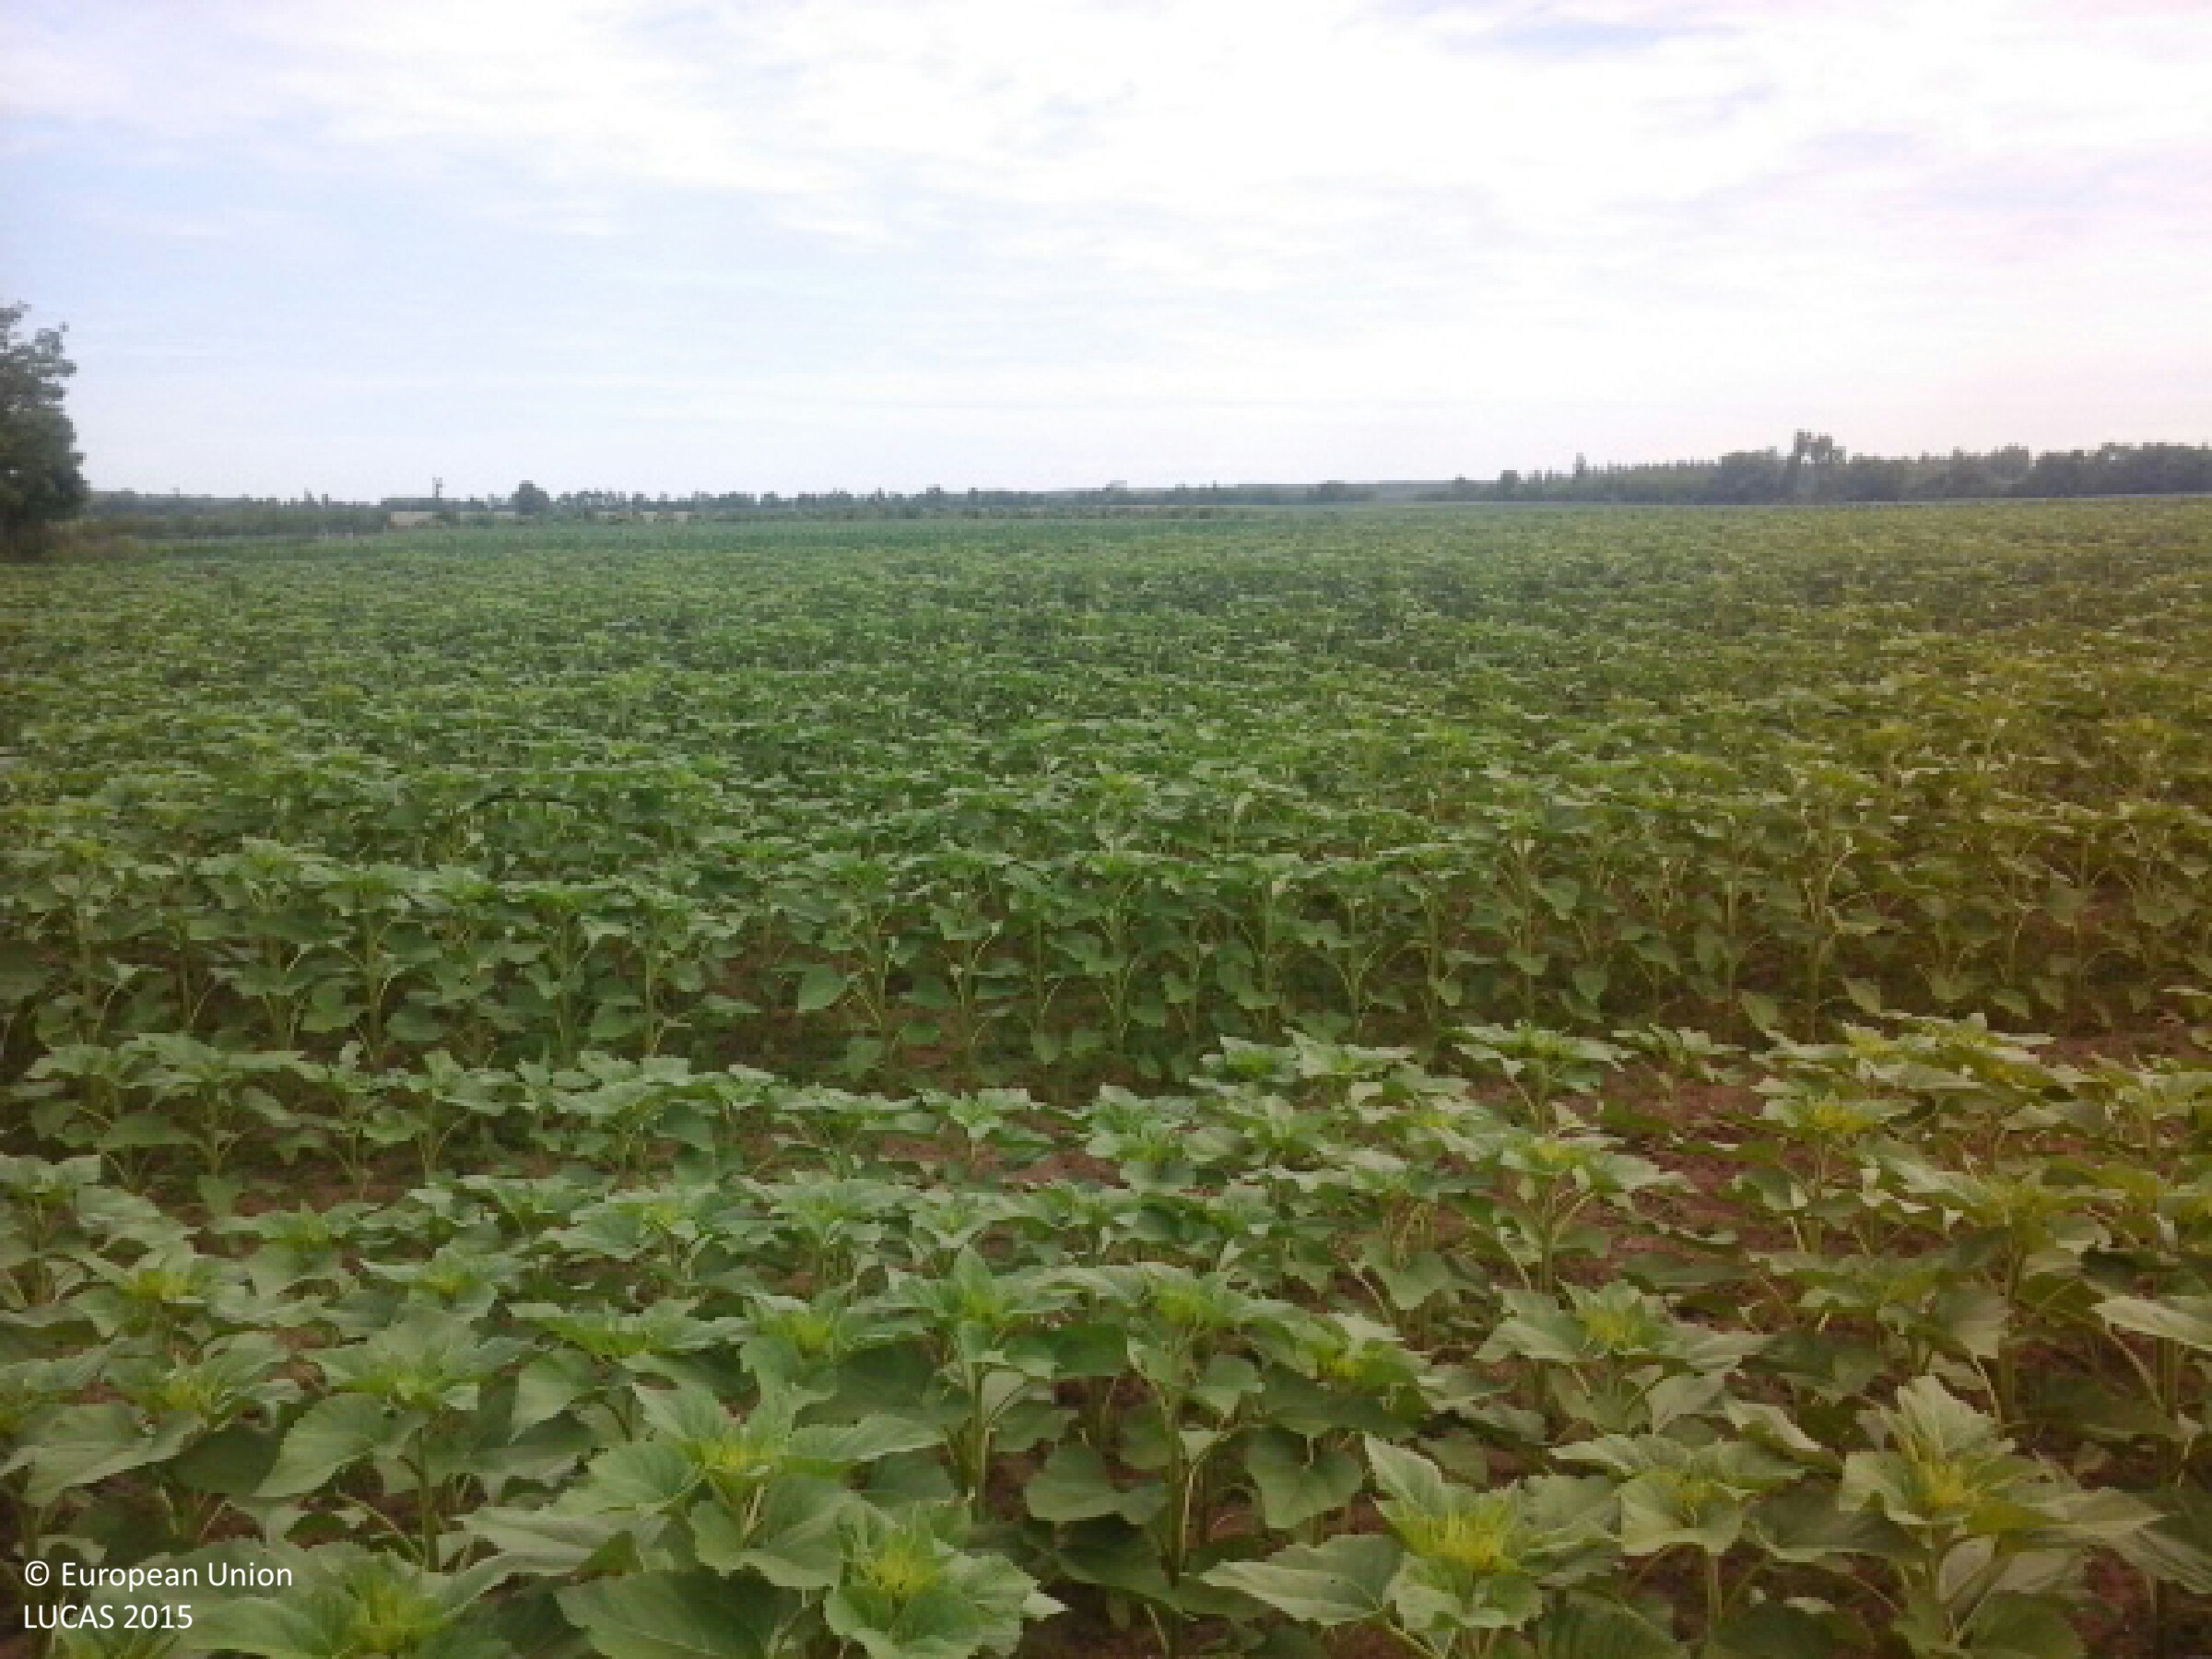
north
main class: Cropland
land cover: Sunflower
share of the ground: 50 - 75 %
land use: Agriculture (excluding fallow land and kitchen gardens)
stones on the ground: < 10 %
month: June
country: HU
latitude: 48.0199
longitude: 21.8352
